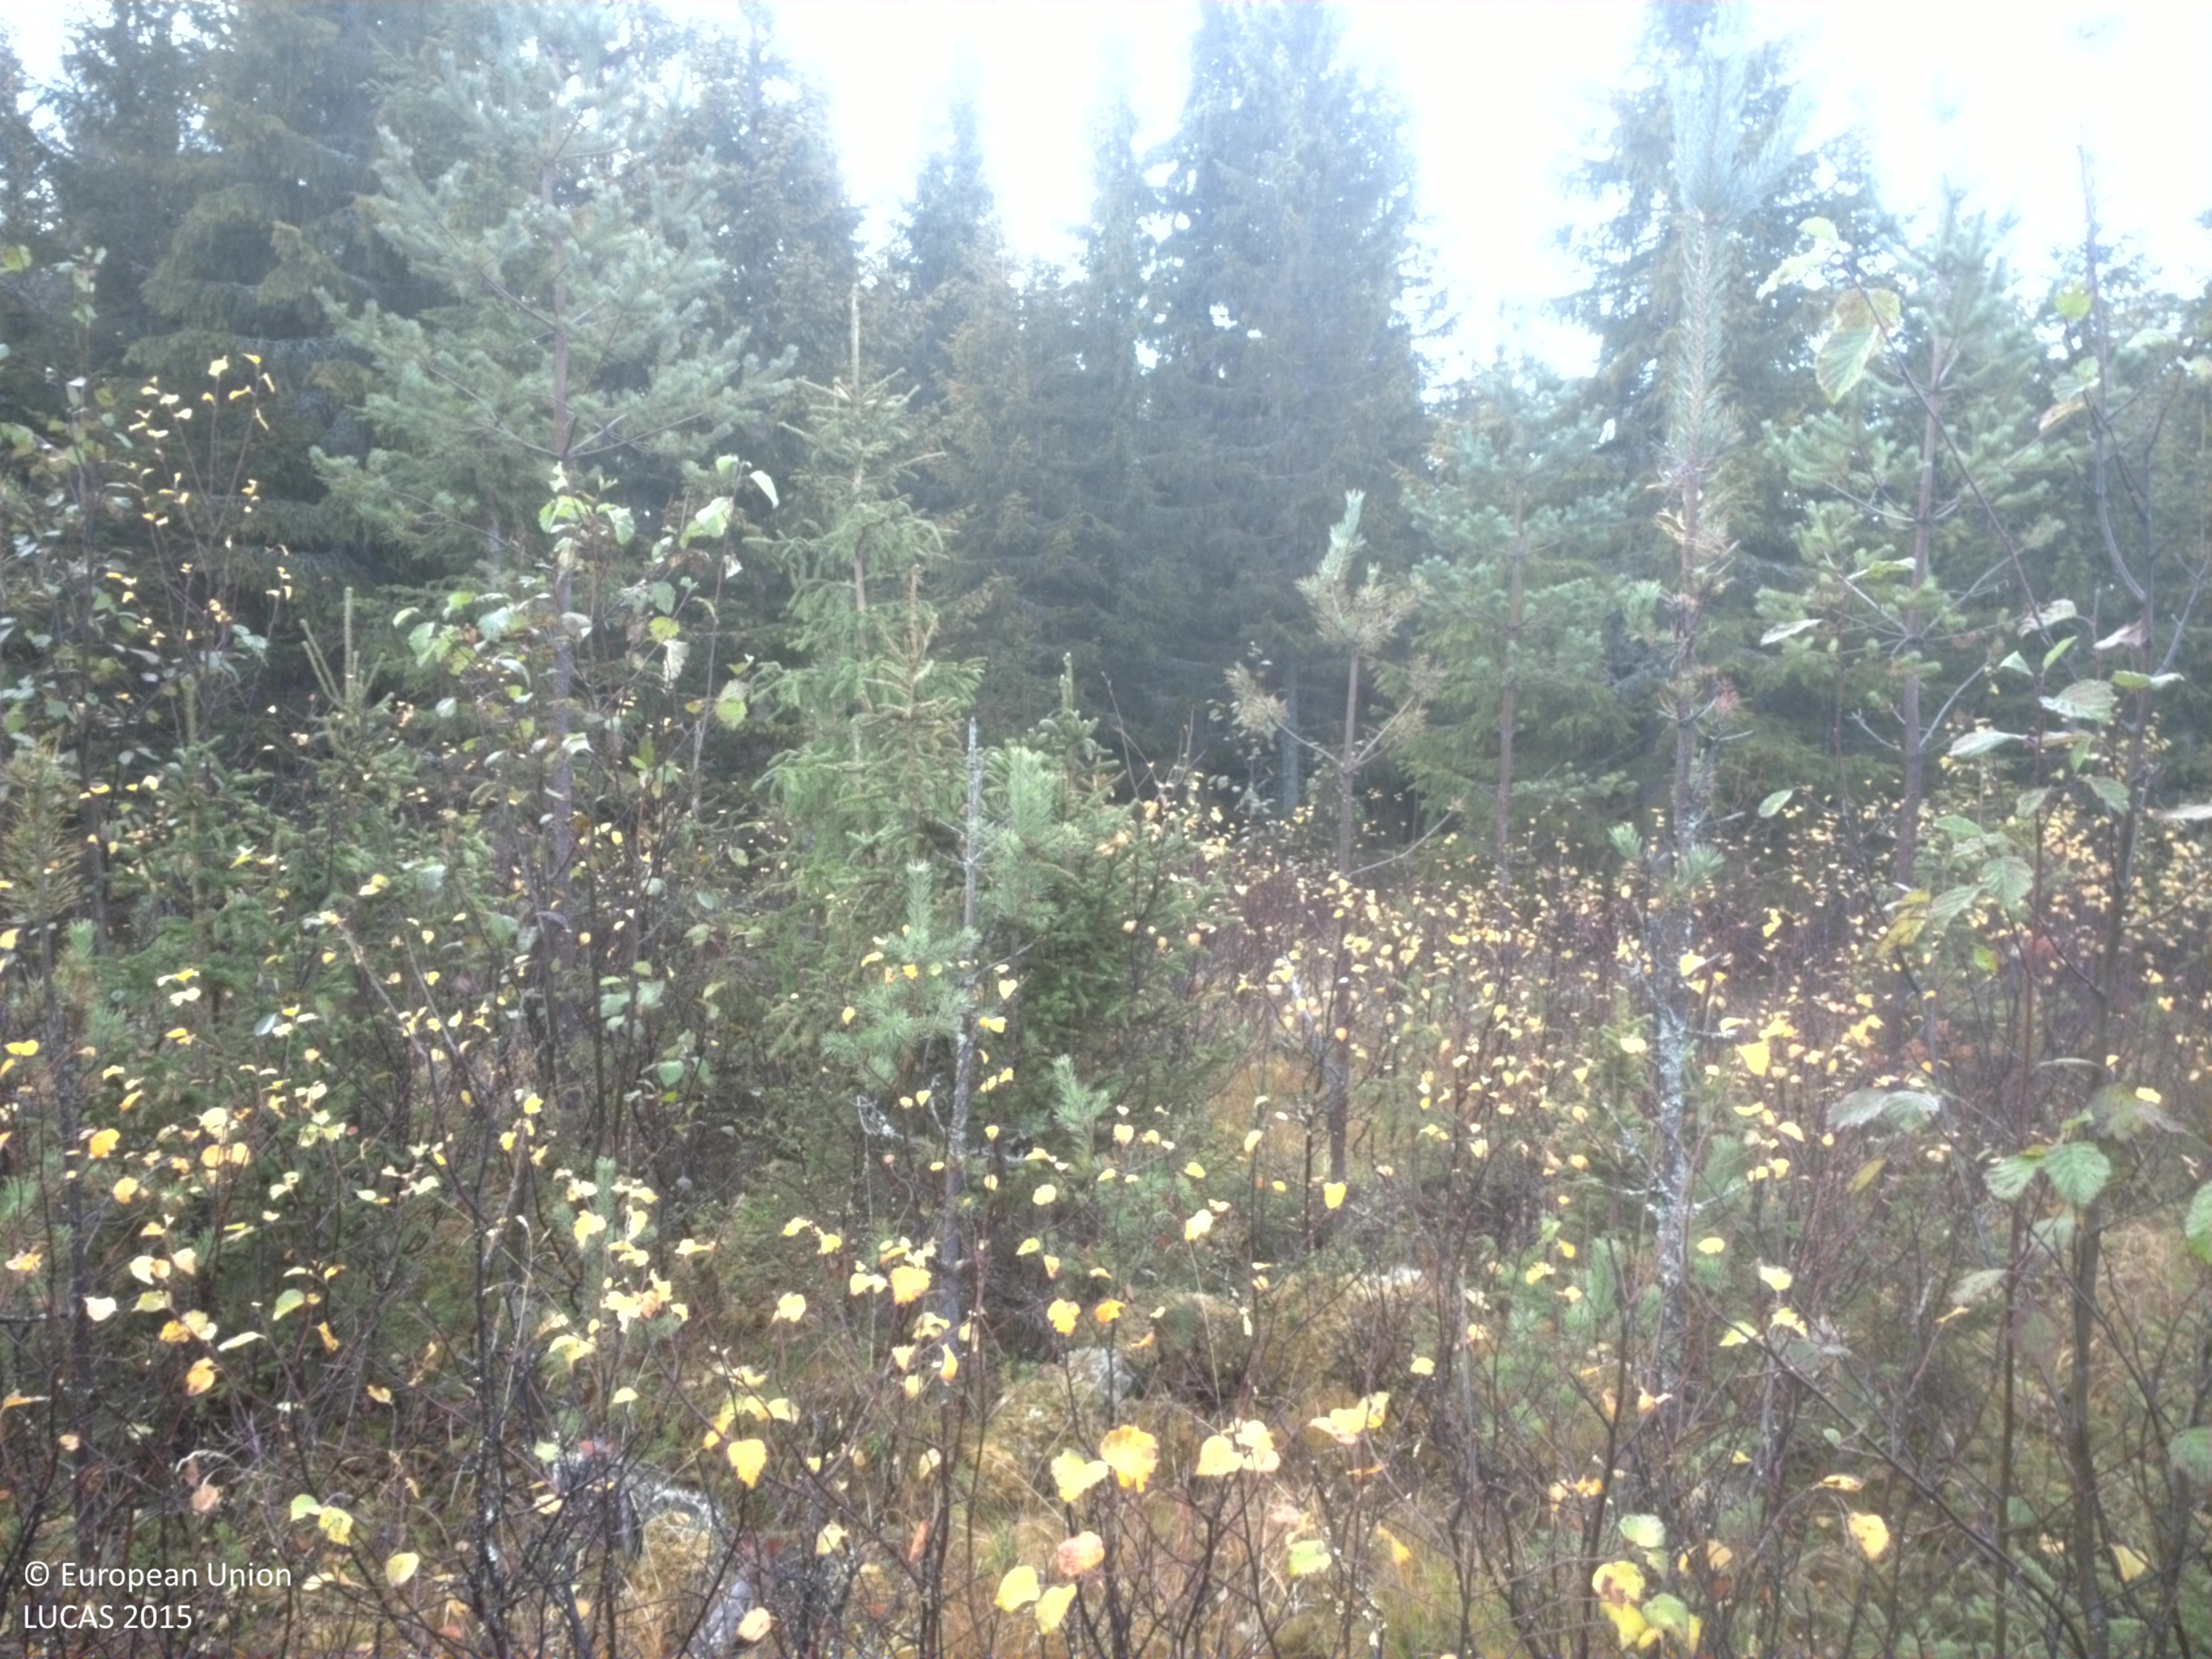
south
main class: Woodland
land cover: Other mixed woodland
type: boreal forest
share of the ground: > 75 %
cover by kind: coniferous forest trees 40 %, broadleaved forest trees 40 %, lichens and mosses 10 %, shrubs 5 %, herbaceous plants 5 %
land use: Forestry
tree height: > 5 m
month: October
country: SE
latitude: 64.1274
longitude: 19.8561
